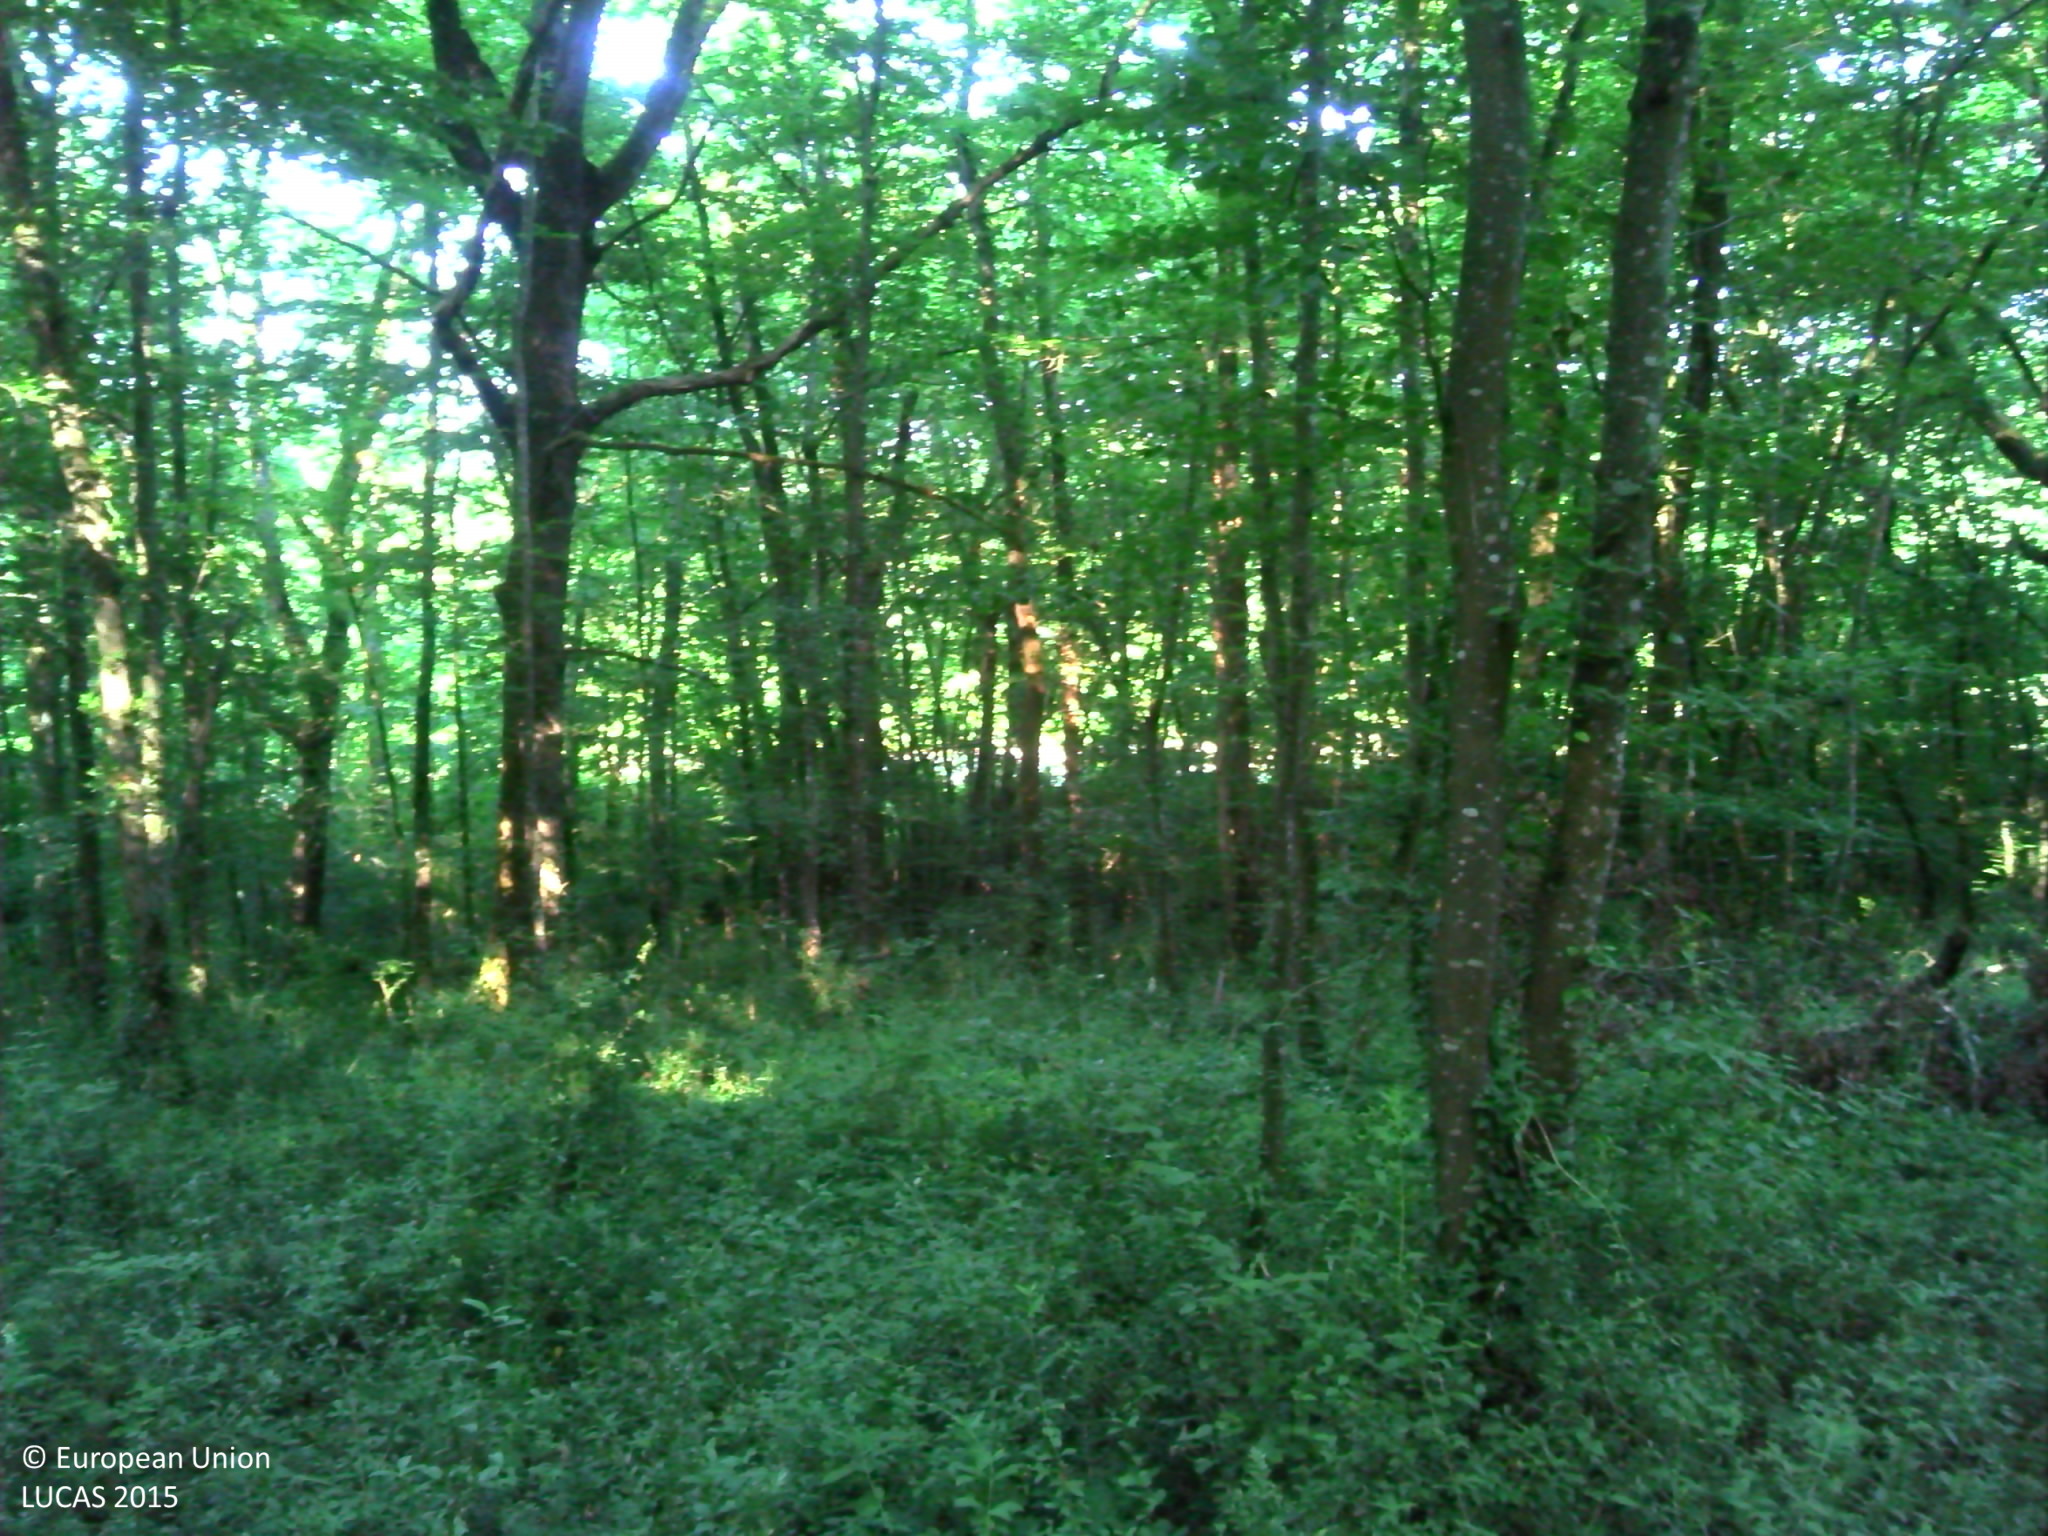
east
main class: Woodland
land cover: Broadleaved woodland
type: mesophytic deciduous forest
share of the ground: > 75 %
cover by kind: broadleaved forest trees 85 %, shrubs 10 %, herbaceous plants 5 %
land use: Forestry
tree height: > 5 m
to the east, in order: Broadleaved woodland; Tracks; Broadleaved woodland; Rivers and streams; Broadleaved woodland; Shruby margins; Grassland without tree/shrub cover; Broadleaved woodland; Rivers and streams; Broadleaved woodland; Grass margins; Broadleaved woodland; Grassland without tree/shrub cover; Broadleaved woodland; Grassland without tree/shrub cover
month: June
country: FR
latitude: 43.6944
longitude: 0.6801
